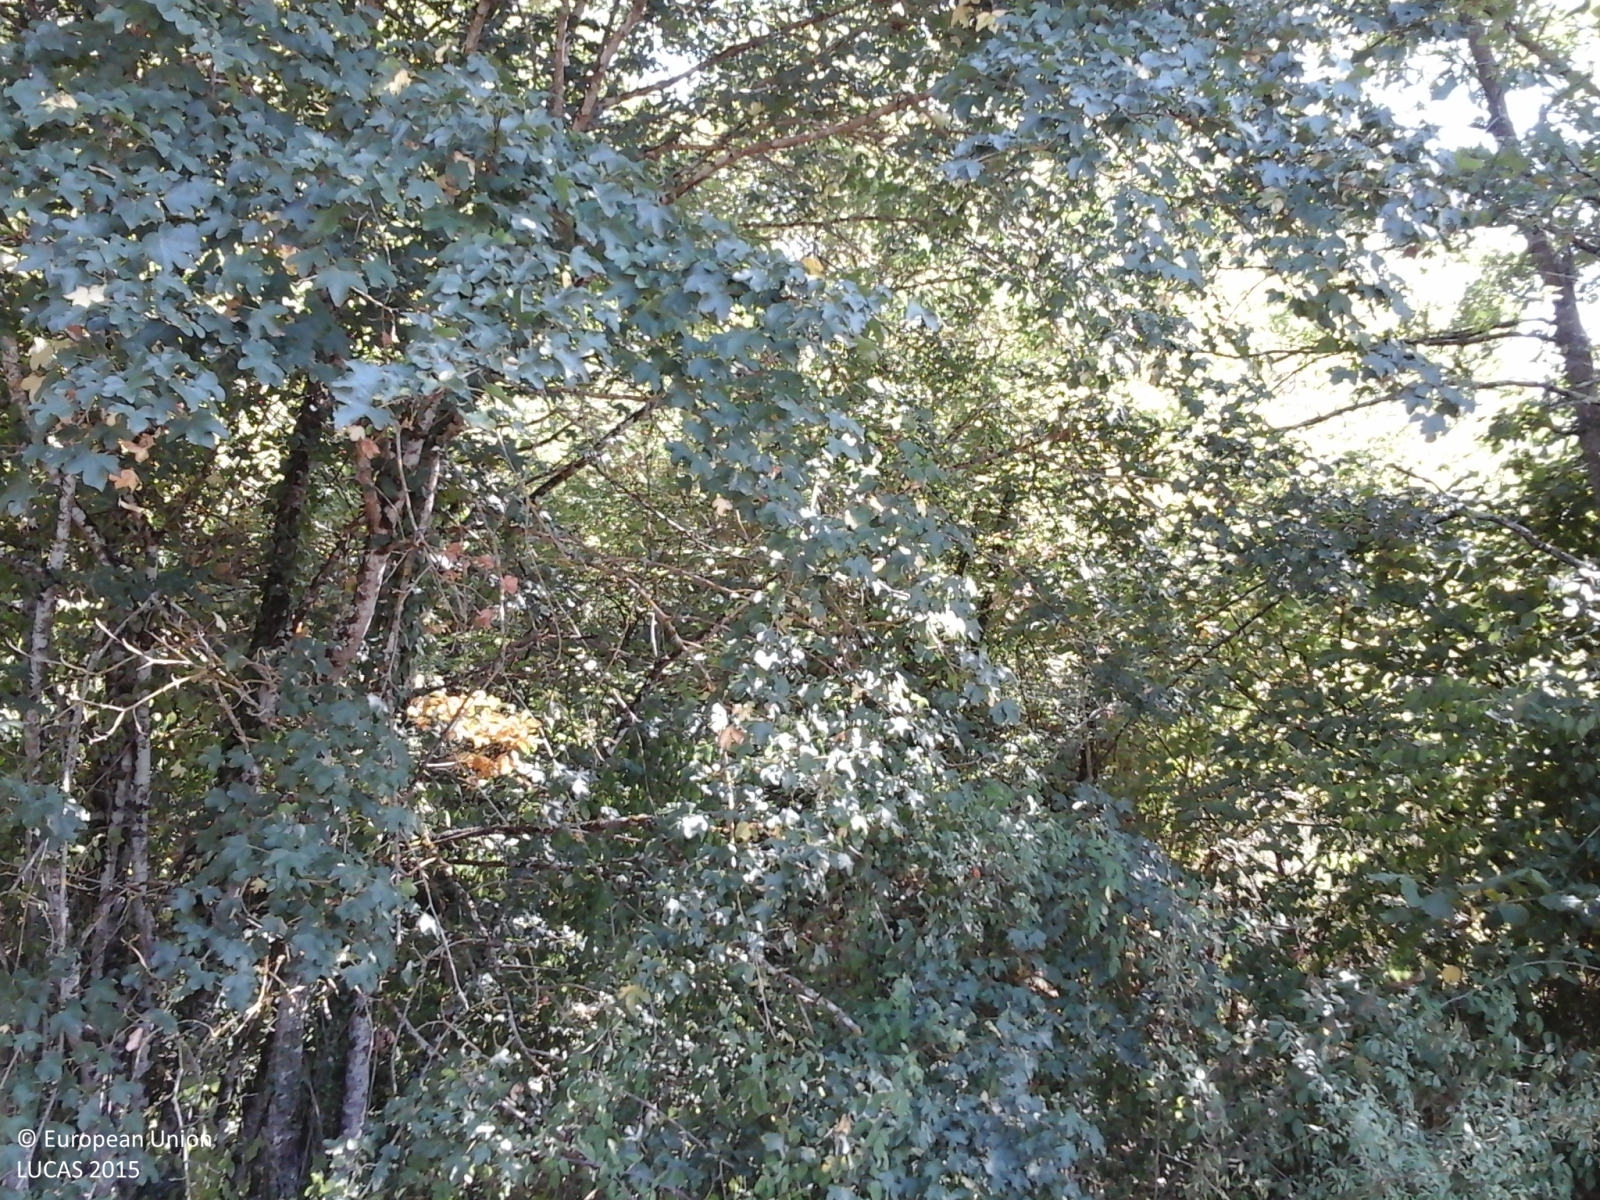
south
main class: Woodland
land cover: Broadleaved woodland
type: thermophilous deciduous forest
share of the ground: > 75 %
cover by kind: broadleaved forest trees 80 %, shrubs 15 %, herbaceous plants 5 %
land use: Semi-natural and natural areas not in use
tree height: > 5 m
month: September
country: IT
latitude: 41.6624
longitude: 14.2005
